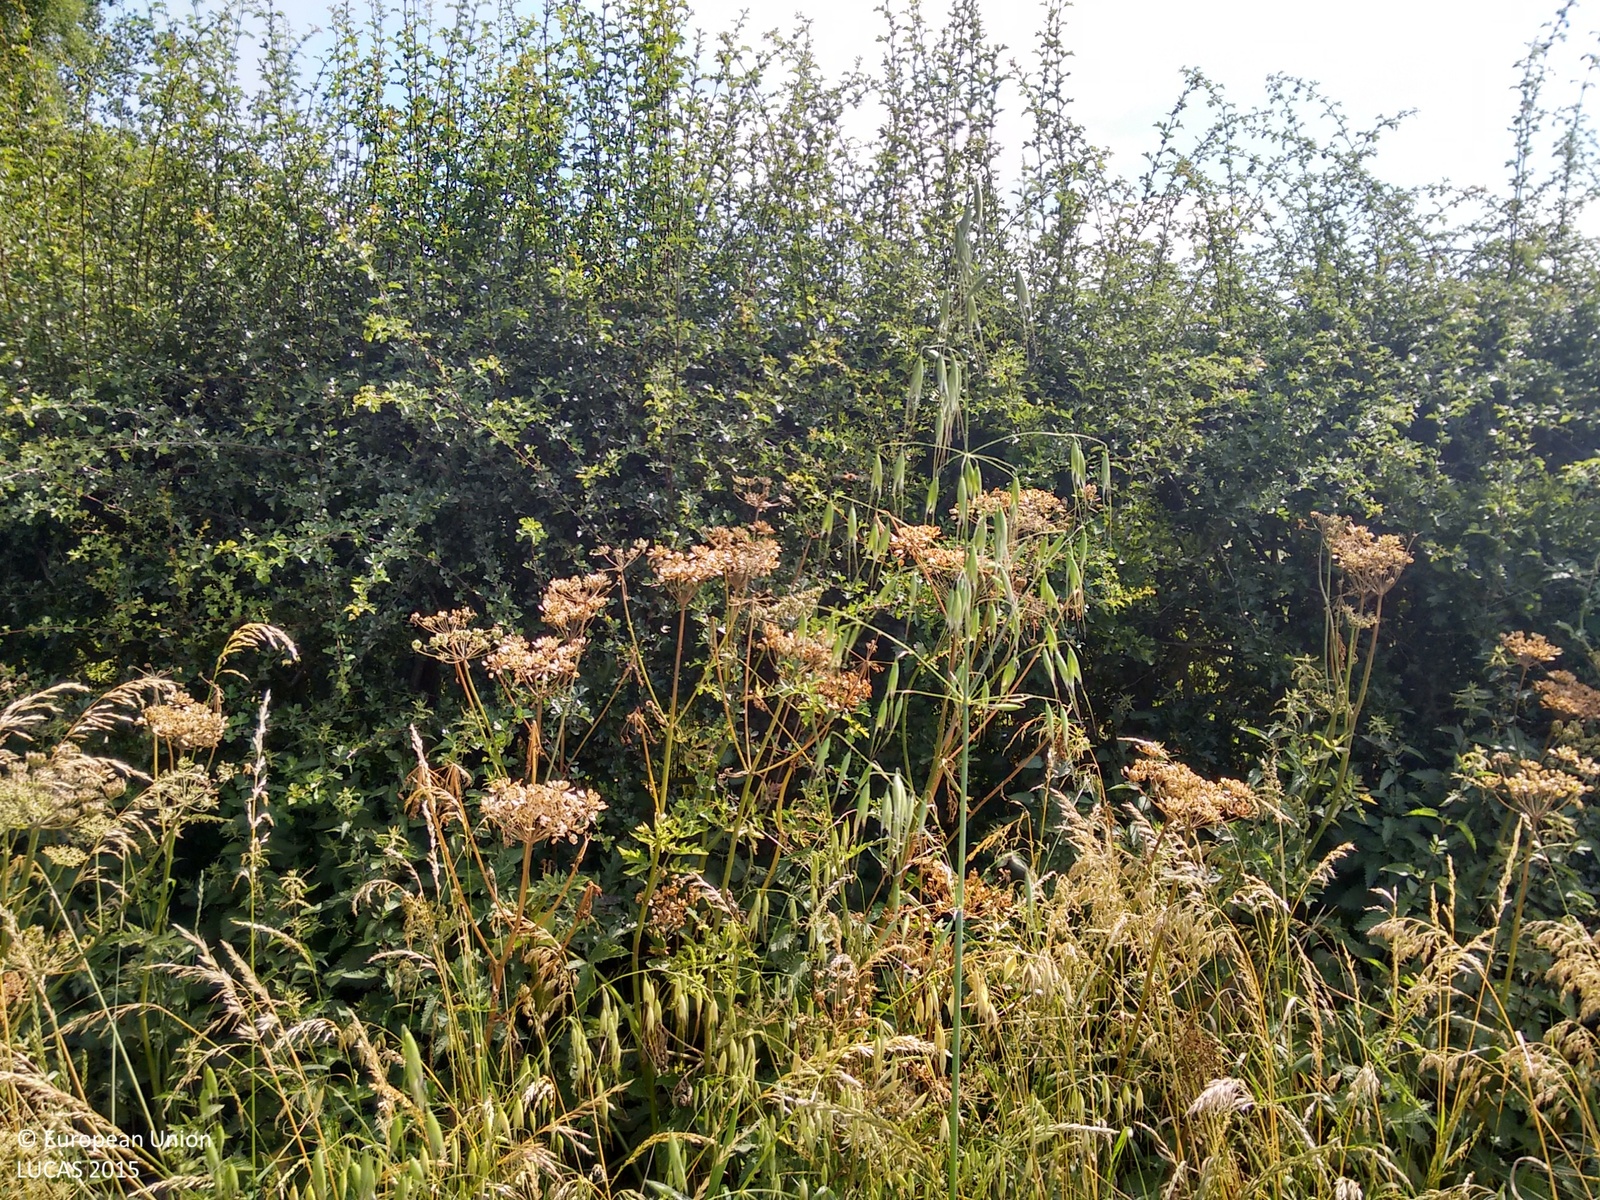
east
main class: Cropland
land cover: Common wheat
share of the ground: > 75 %
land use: Agriculture (excluding fallow land and kitchen gardens)
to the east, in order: Common wheat; Grass margins; Managed hedges; Grass margins; Common wheat
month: July
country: GB
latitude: 53.1690
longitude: -0.8270
